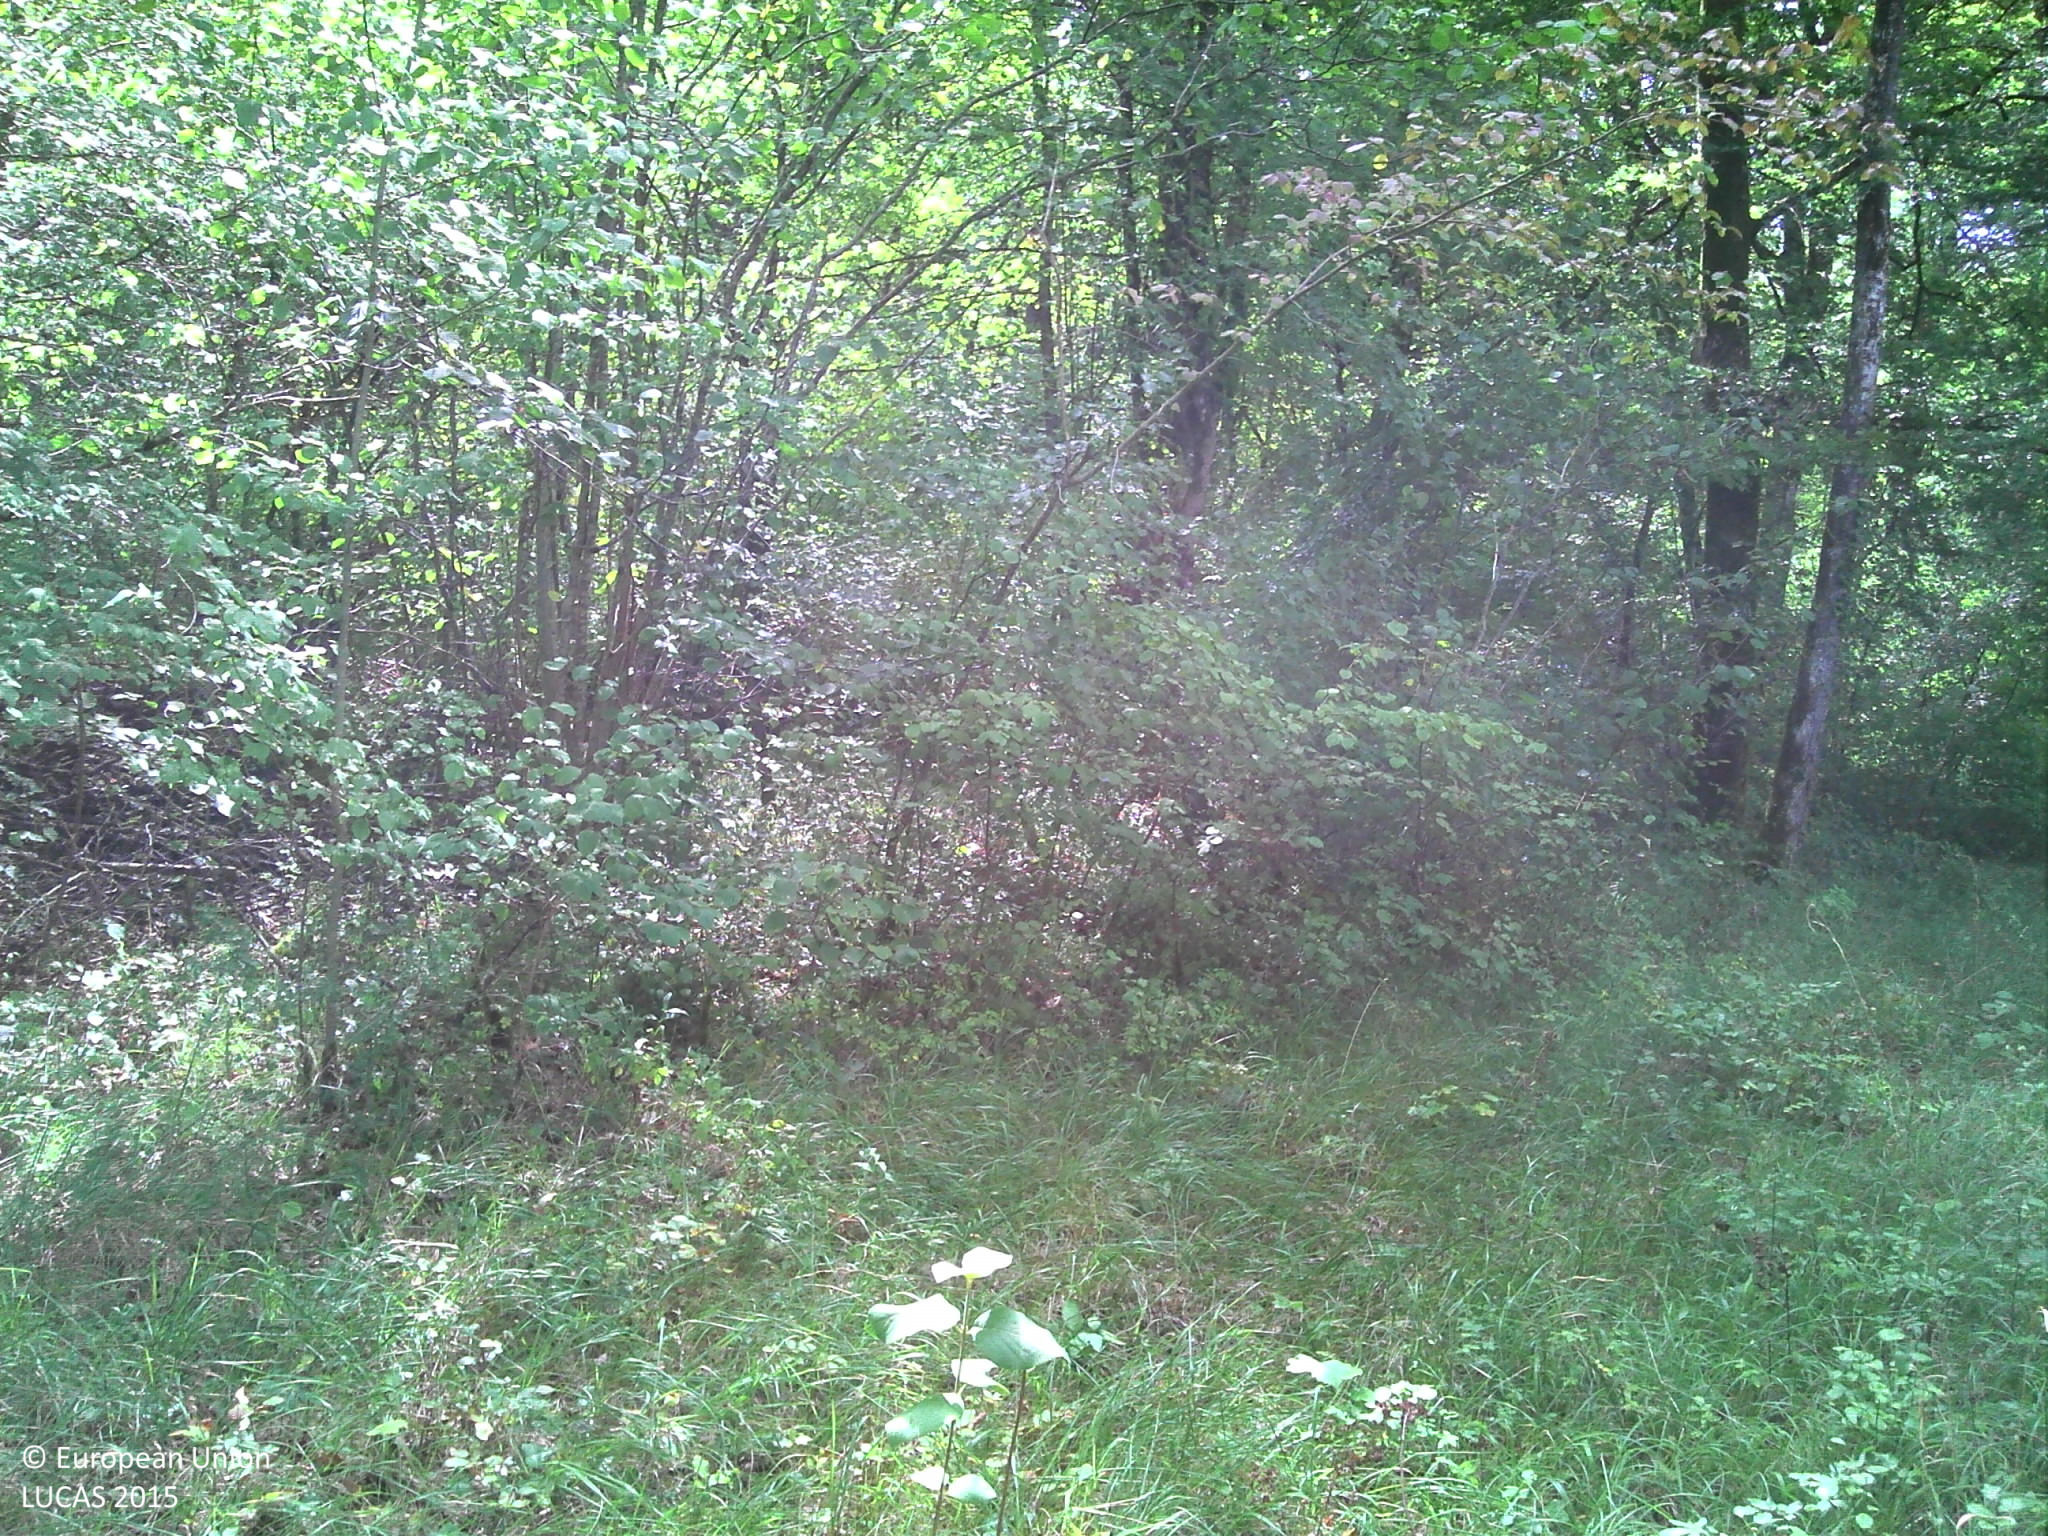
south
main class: Woodland
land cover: Broadleaved woodland
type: mesophytic deciduous forest
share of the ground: > 75 %
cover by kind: broadleaved forest trees 85 %, herbaceous plants 10 %, lichens and mosses 5 %
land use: Forestry
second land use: Amenities, museums, leisure
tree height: > 5 m
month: August
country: FR
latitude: 47.7111
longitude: 4.9481
